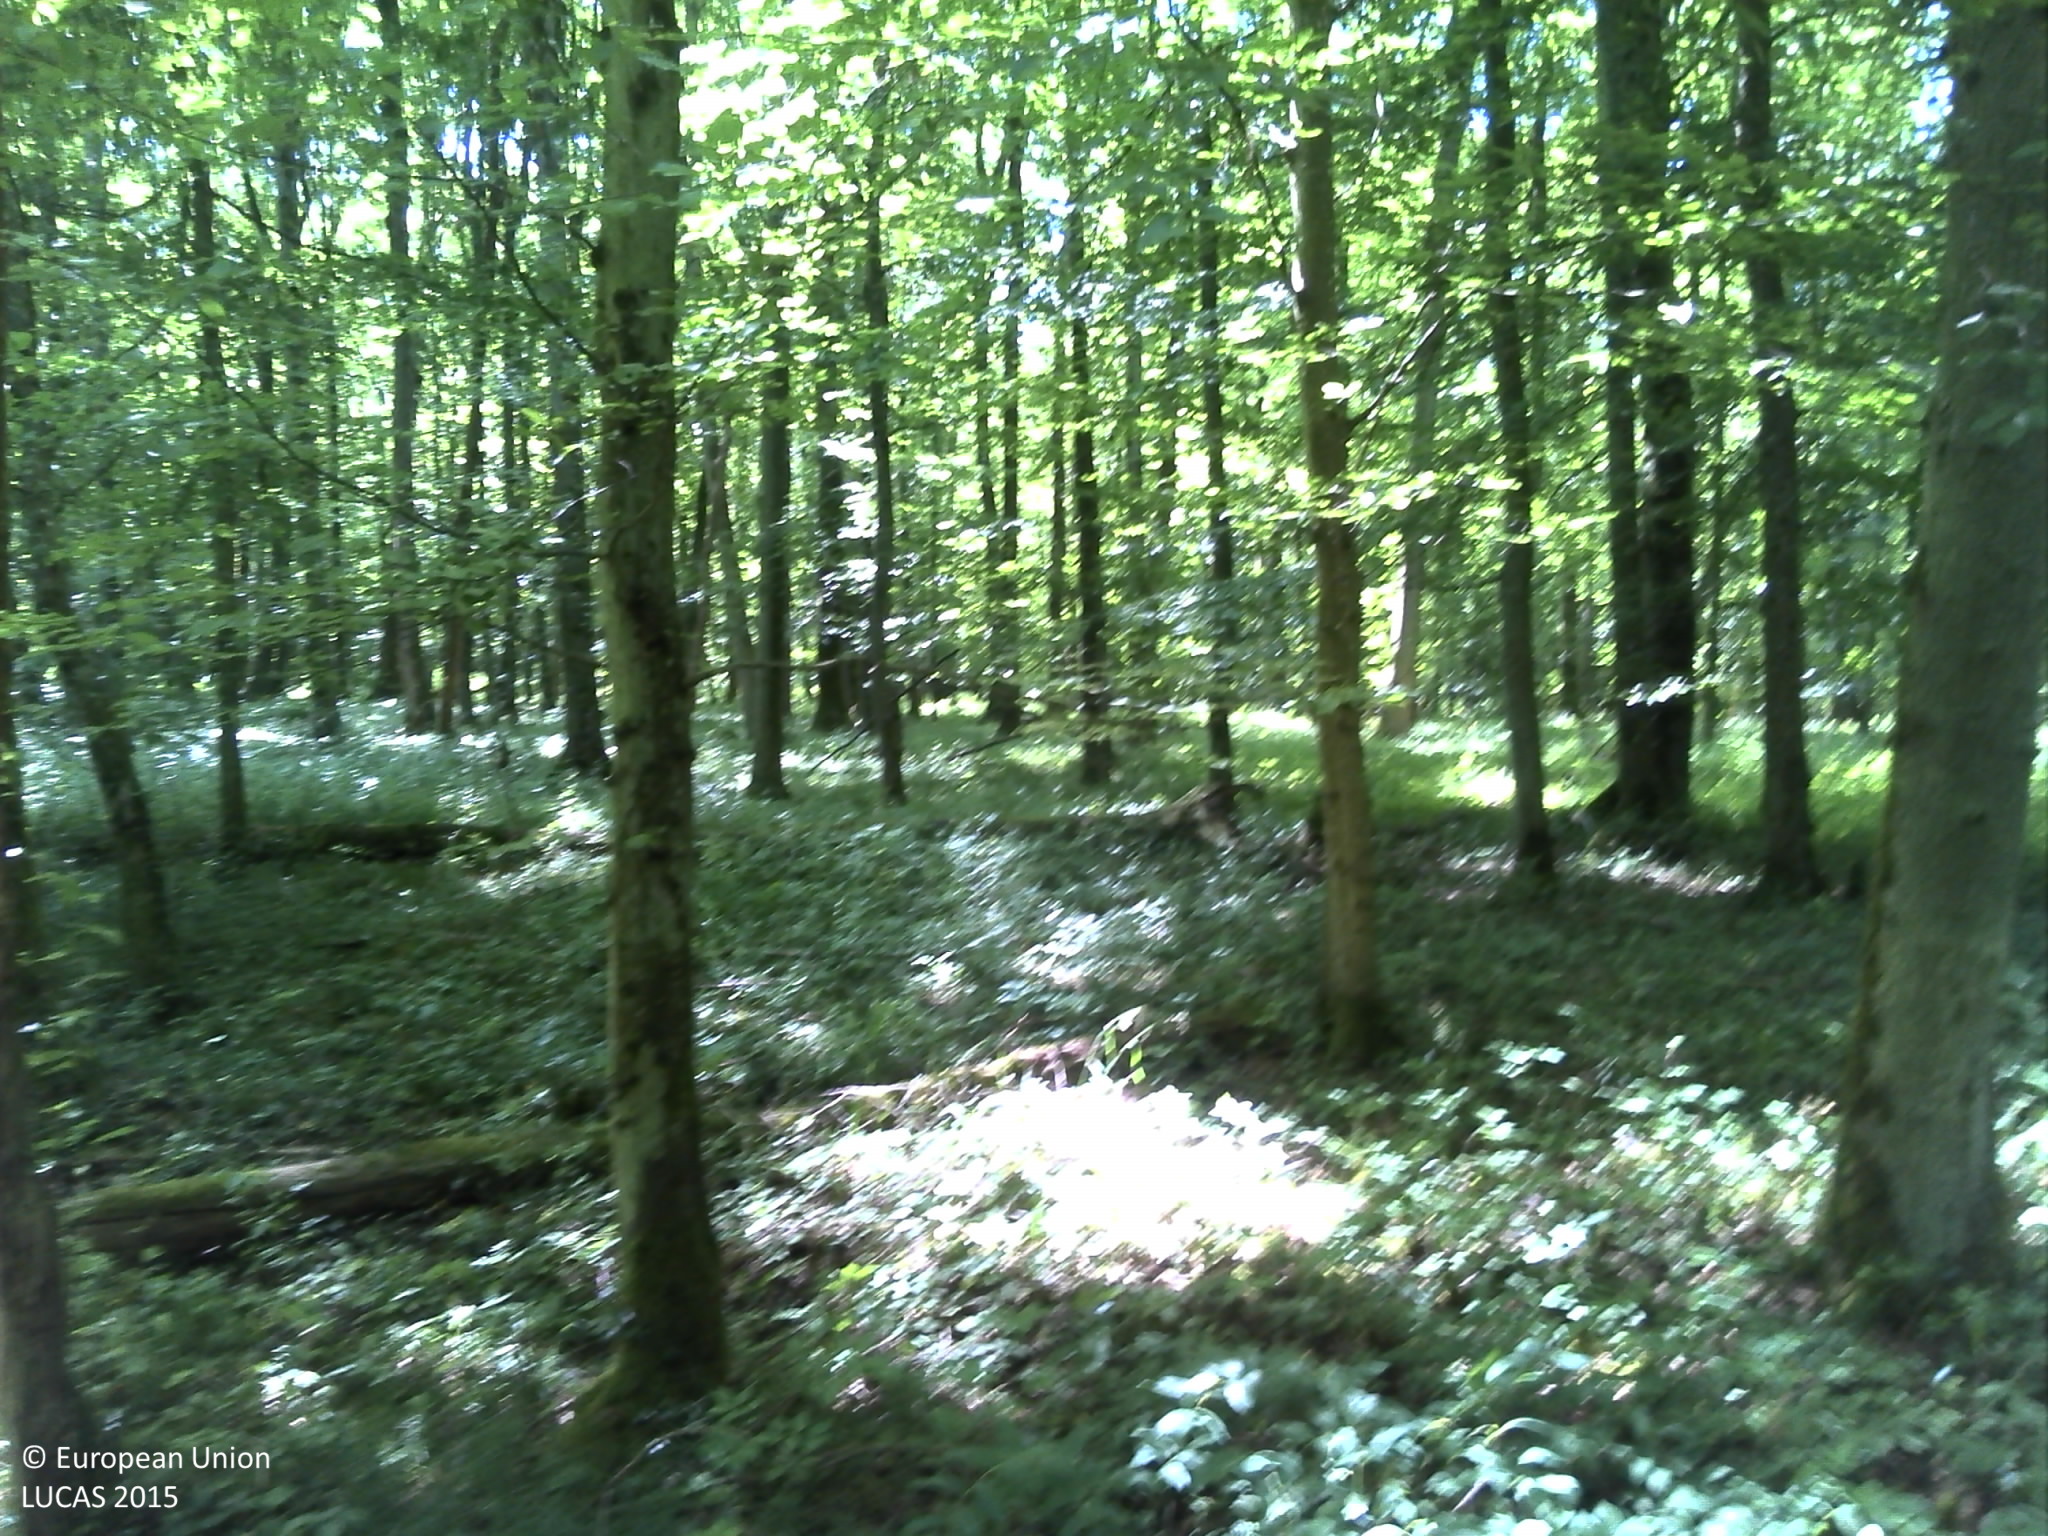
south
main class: Woodland
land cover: Broadleaved woodland
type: mesophytic deciduous forest
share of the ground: > 75 %
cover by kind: broadleaved forest trees 95 %, herbaceous plants 5 %
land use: Forestry
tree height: > 5 m
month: June
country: FR
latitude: 49.3804
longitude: 6.1289
